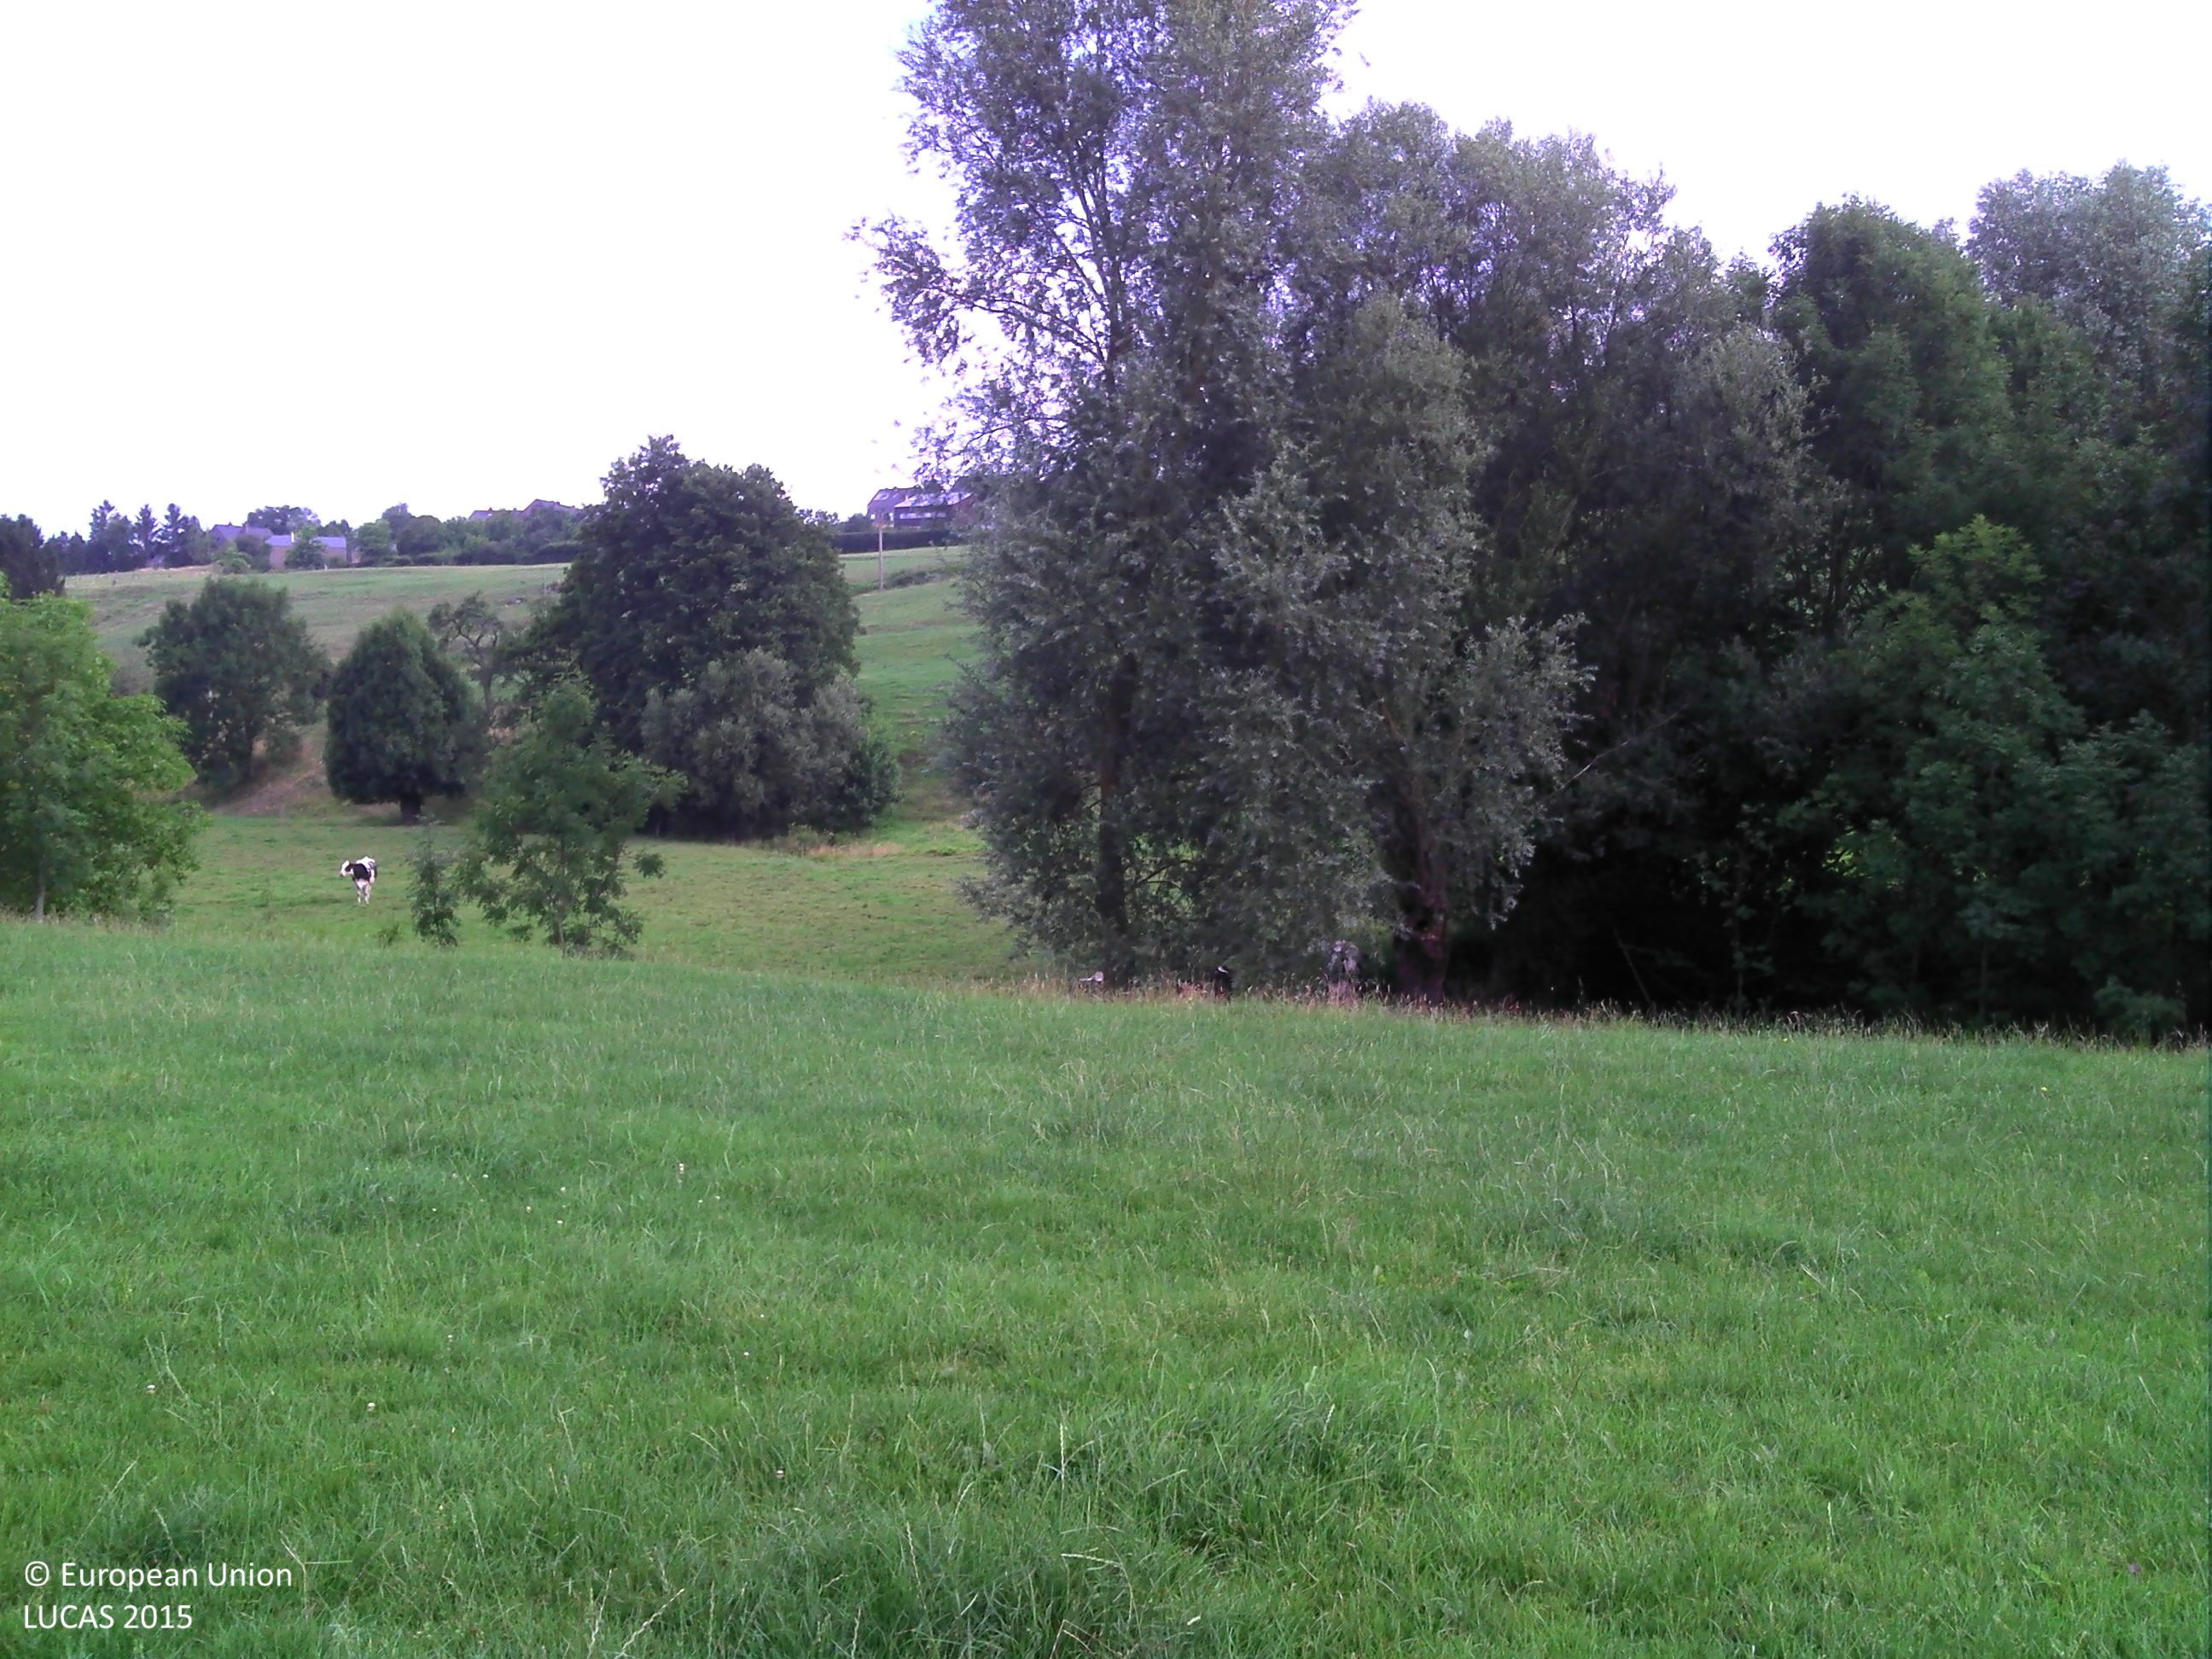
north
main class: Grassland
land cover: Grassland without tree/shrub cover
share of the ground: > 75 %
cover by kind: herbaceous plants 100 %
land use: Agriculture (excluding fallow land and kitchen gardens)
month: July
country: BE
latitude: 50.6449
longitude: 5.7419
